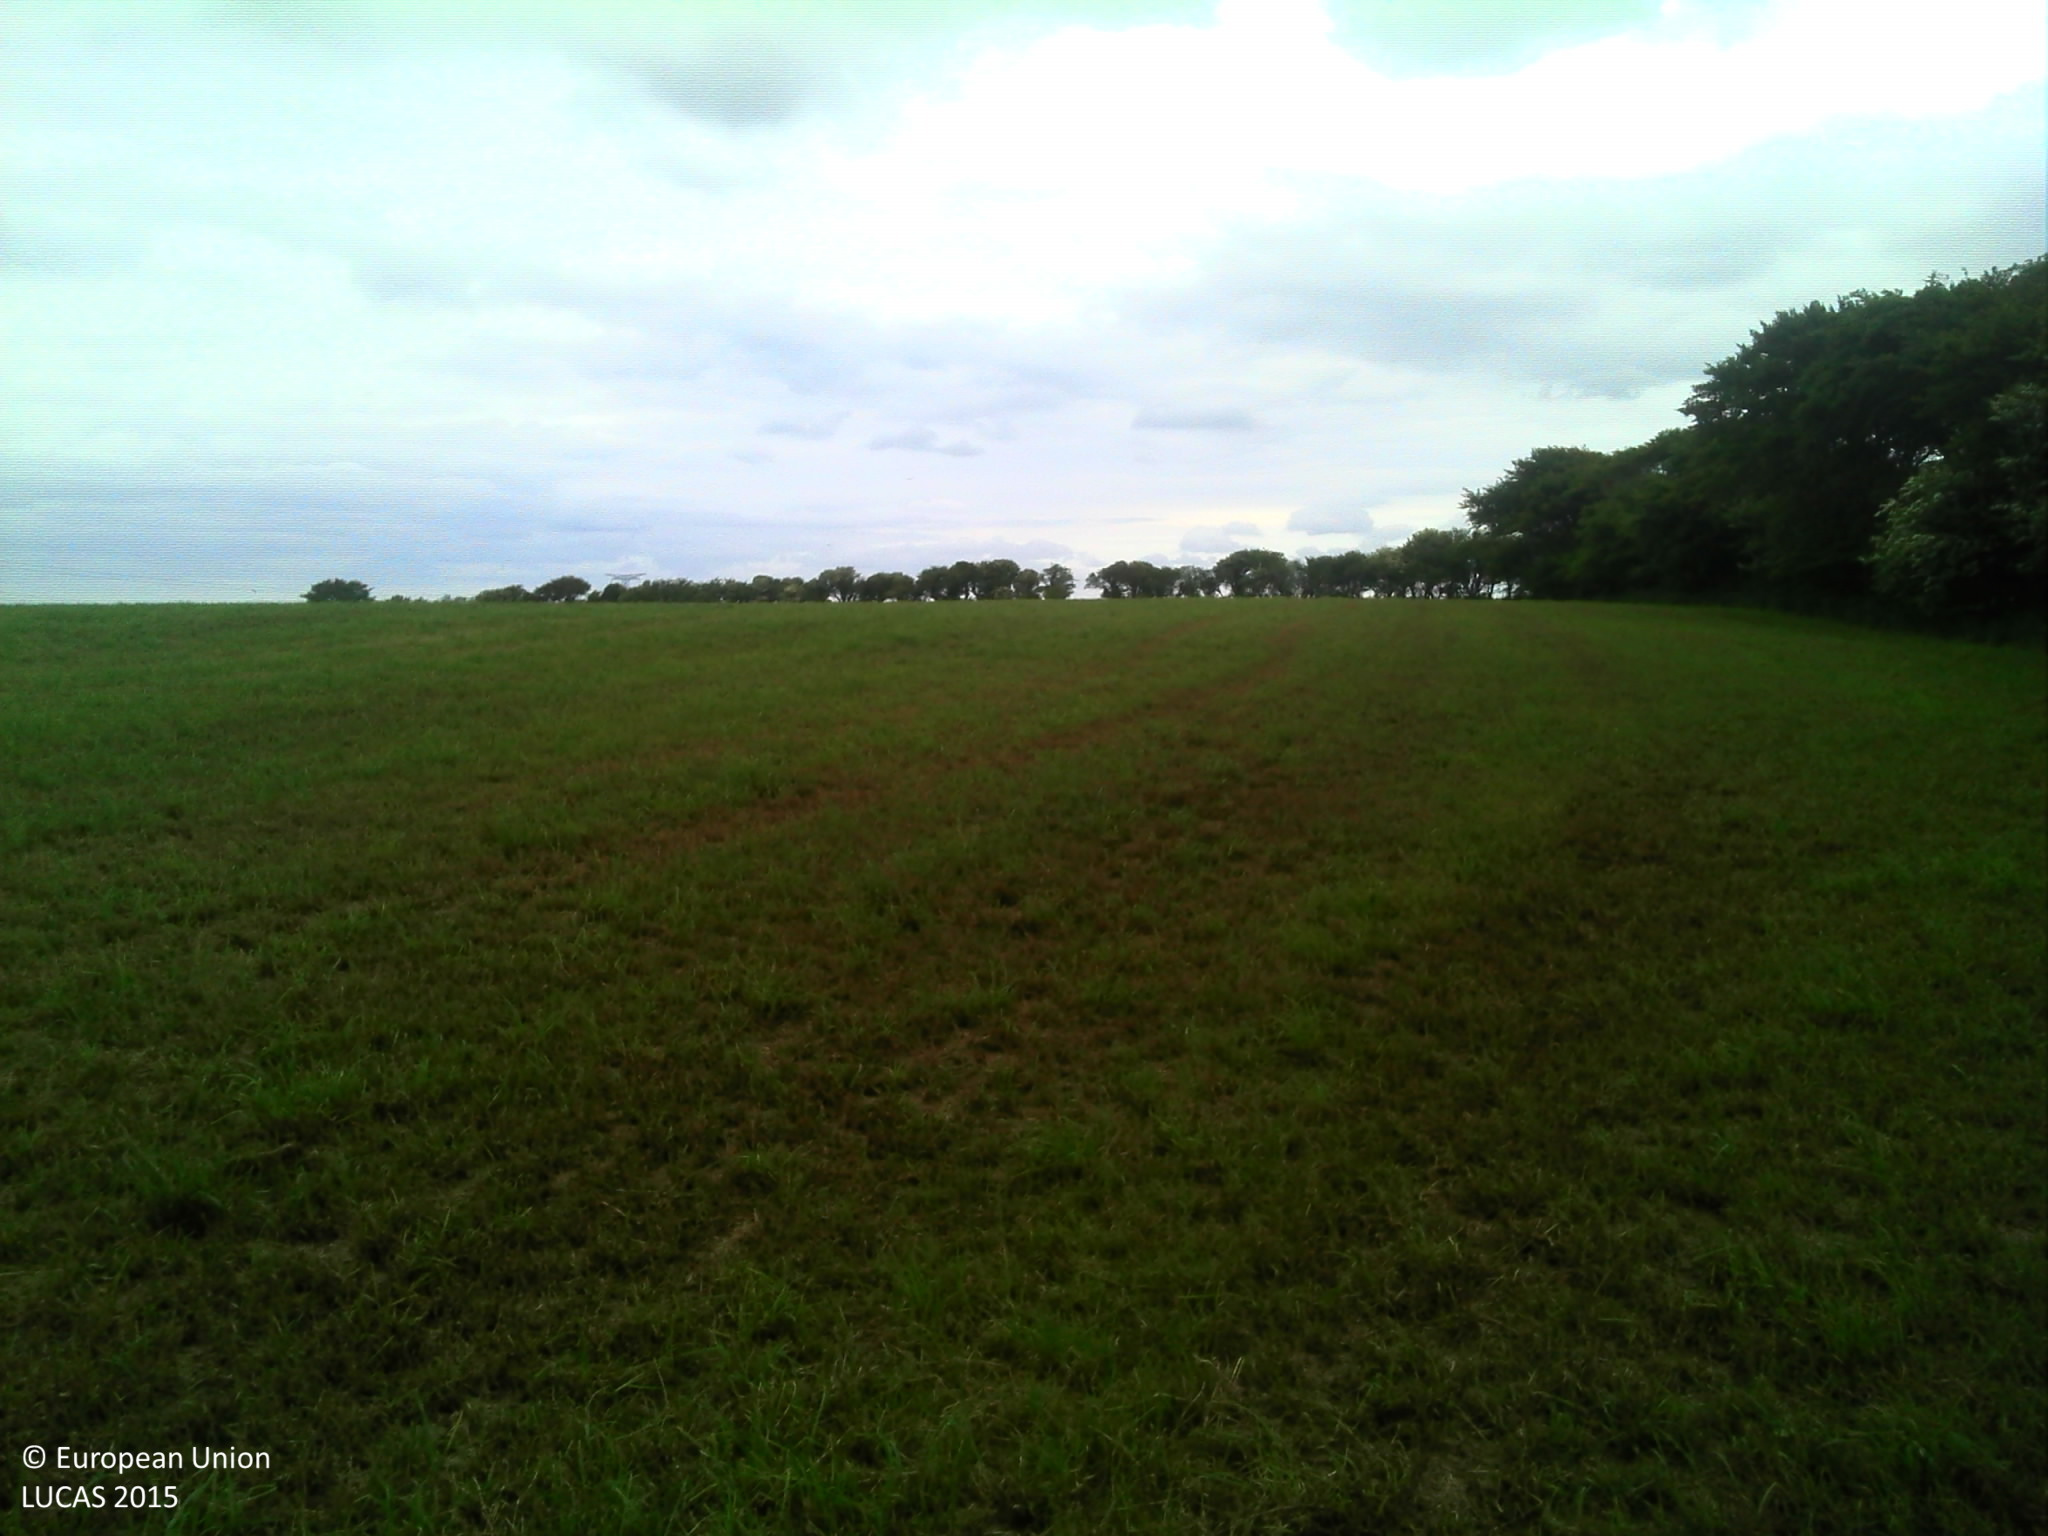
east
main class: Grassland
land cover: Grassland without tree/shrub cover
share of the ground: > 75 %
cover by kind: herbaceous plants 100 %
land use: Agriculture (excluding fallow land and kitchen gardens)
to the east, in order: Grassland without tree/shrub cover; Abandoned hedges; Temporary grasslands
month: June
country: FR
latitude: 49.6583
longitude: -1.8152
